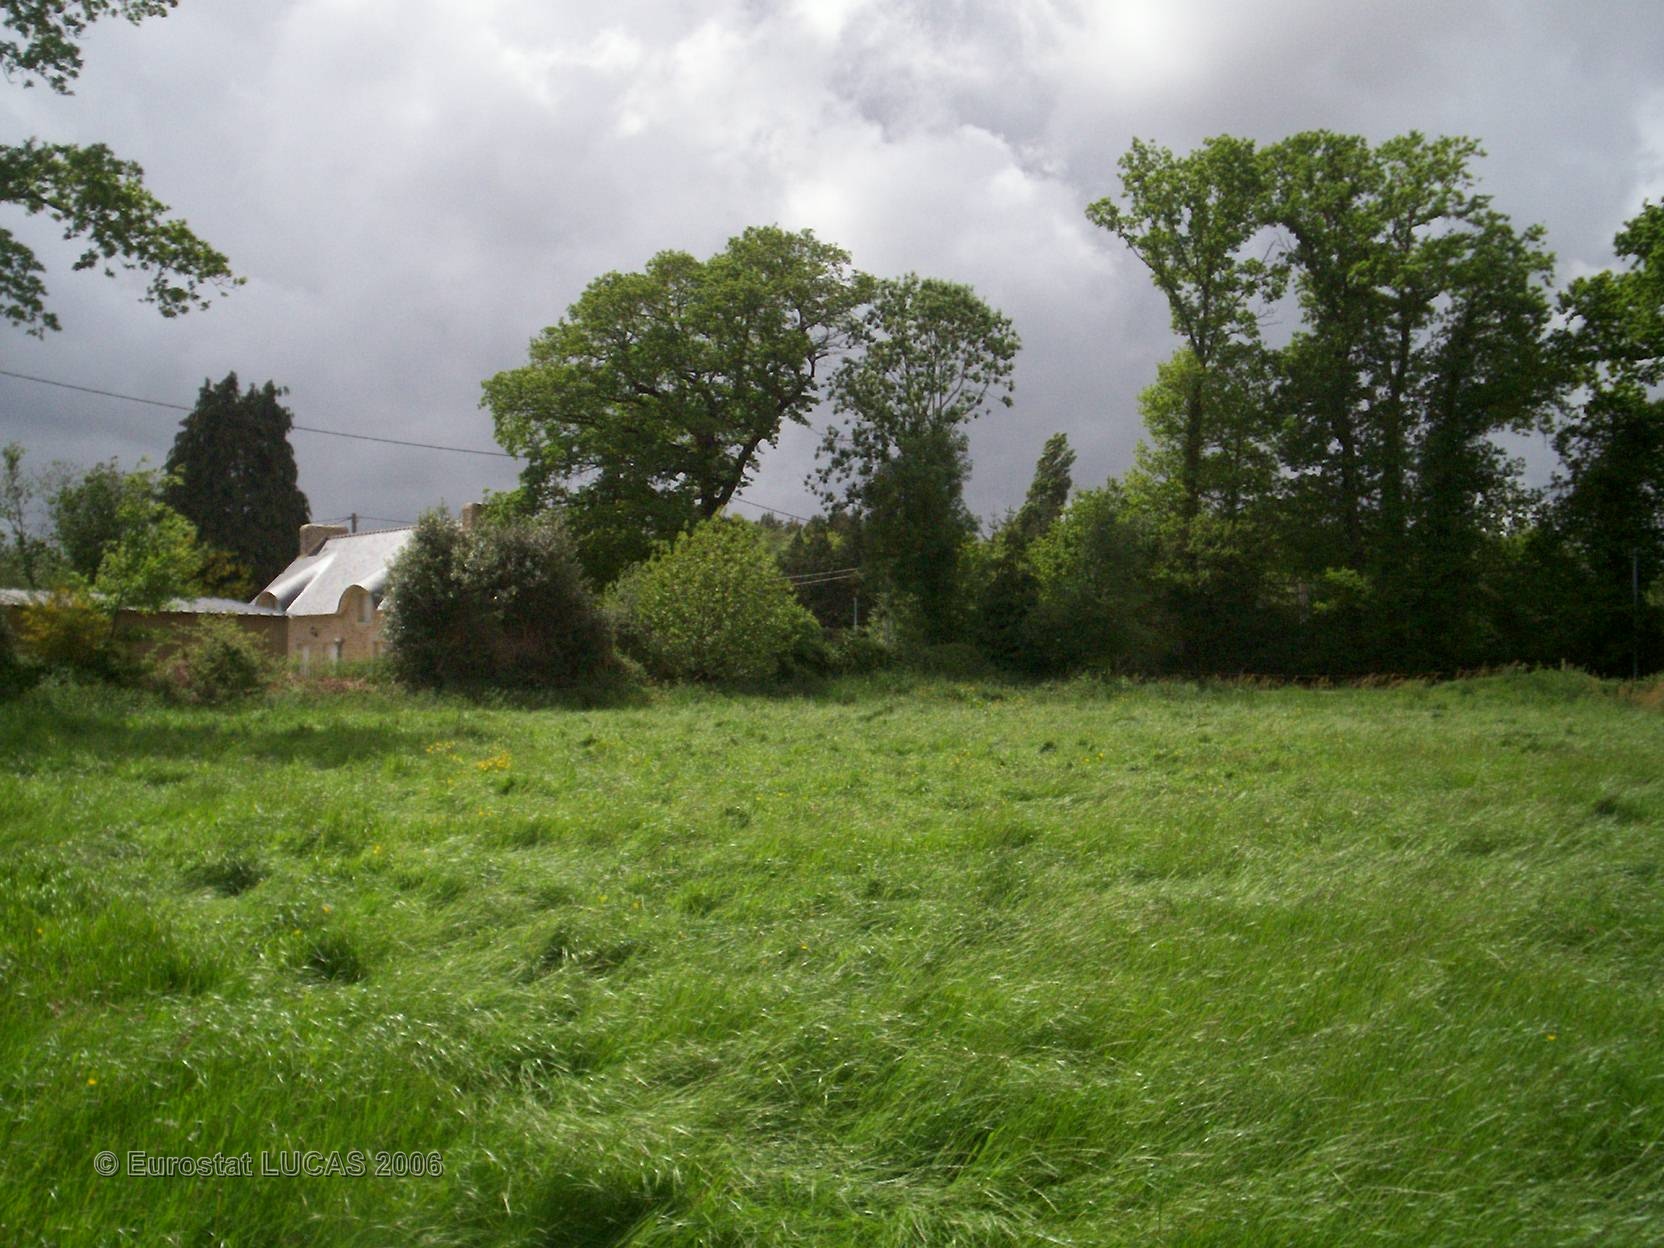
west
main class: Grassland
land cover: Grassland without tree/shrub cover
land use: Agriculture (excluding fallow land and kitchen gardens)
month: May
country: FR
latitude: 47.9092
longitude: -2.8145
